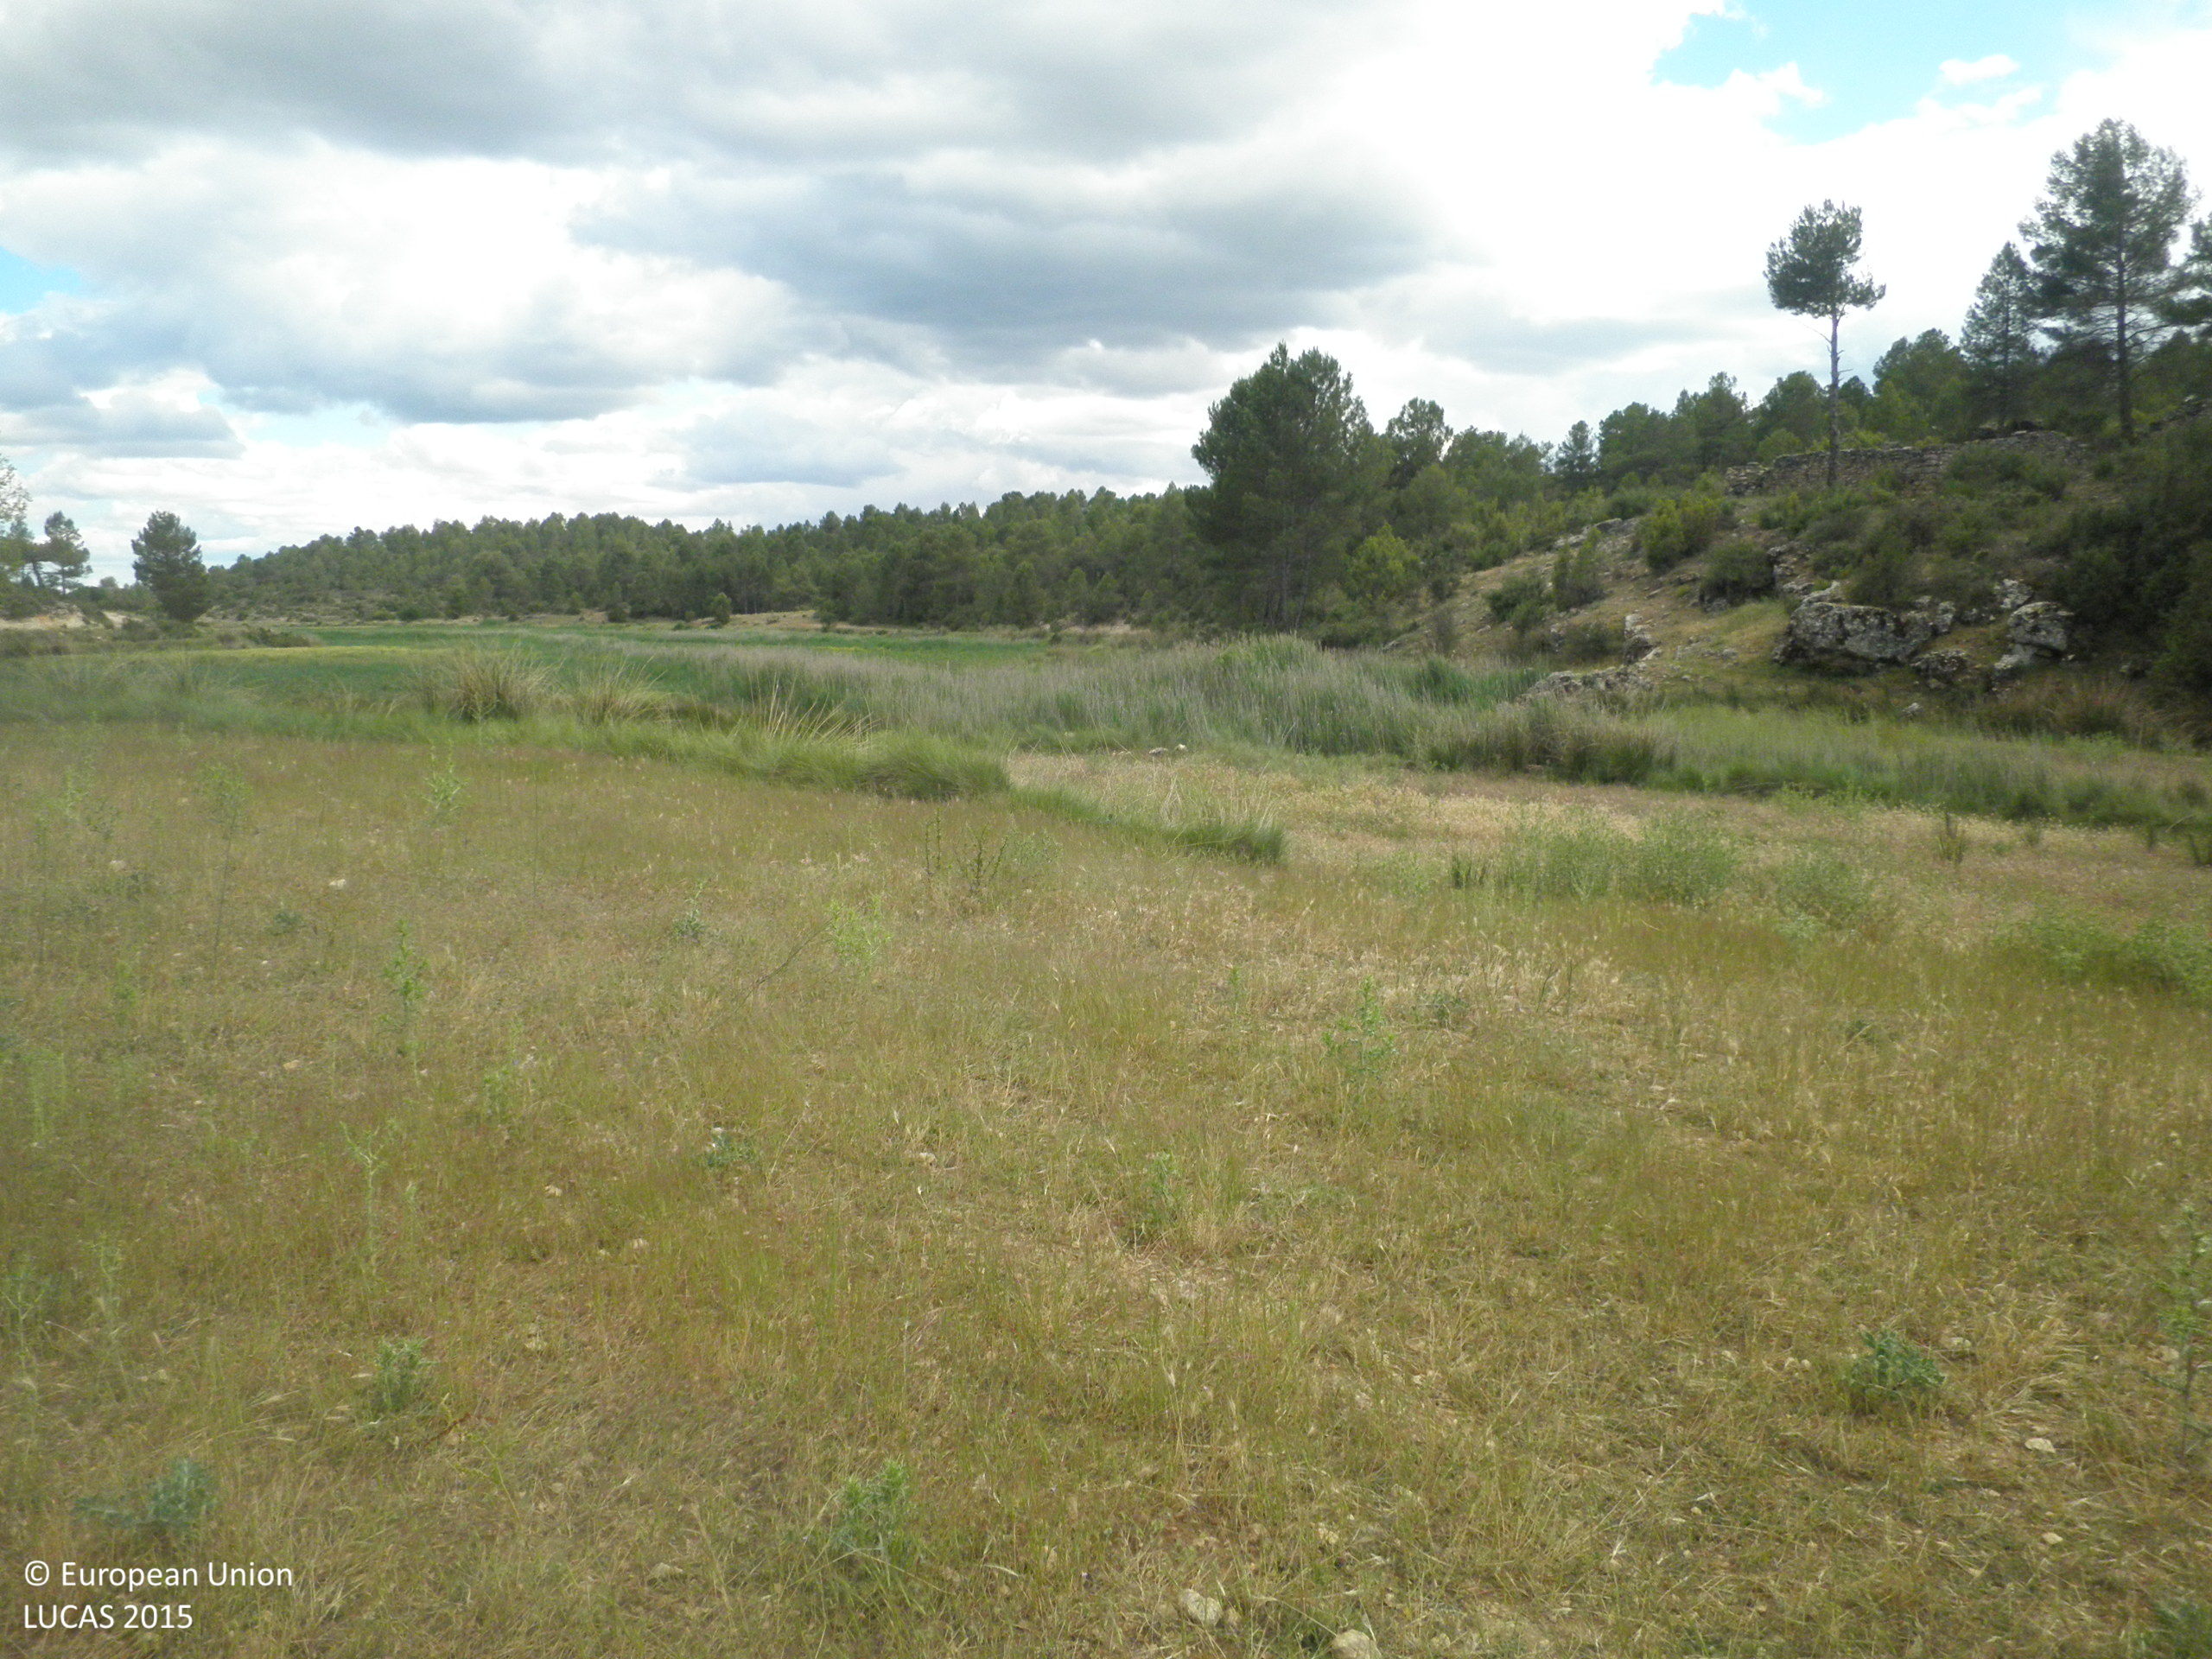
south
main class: Grassland
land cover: Spontaneously vegetated surfaces
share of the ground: > 75 %
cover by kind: herbaceous plants 90 %, unconsolidated bare surface 10 %
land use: Abandoned areas
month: June
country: ES
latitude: 39.7966
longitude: -1.7464
